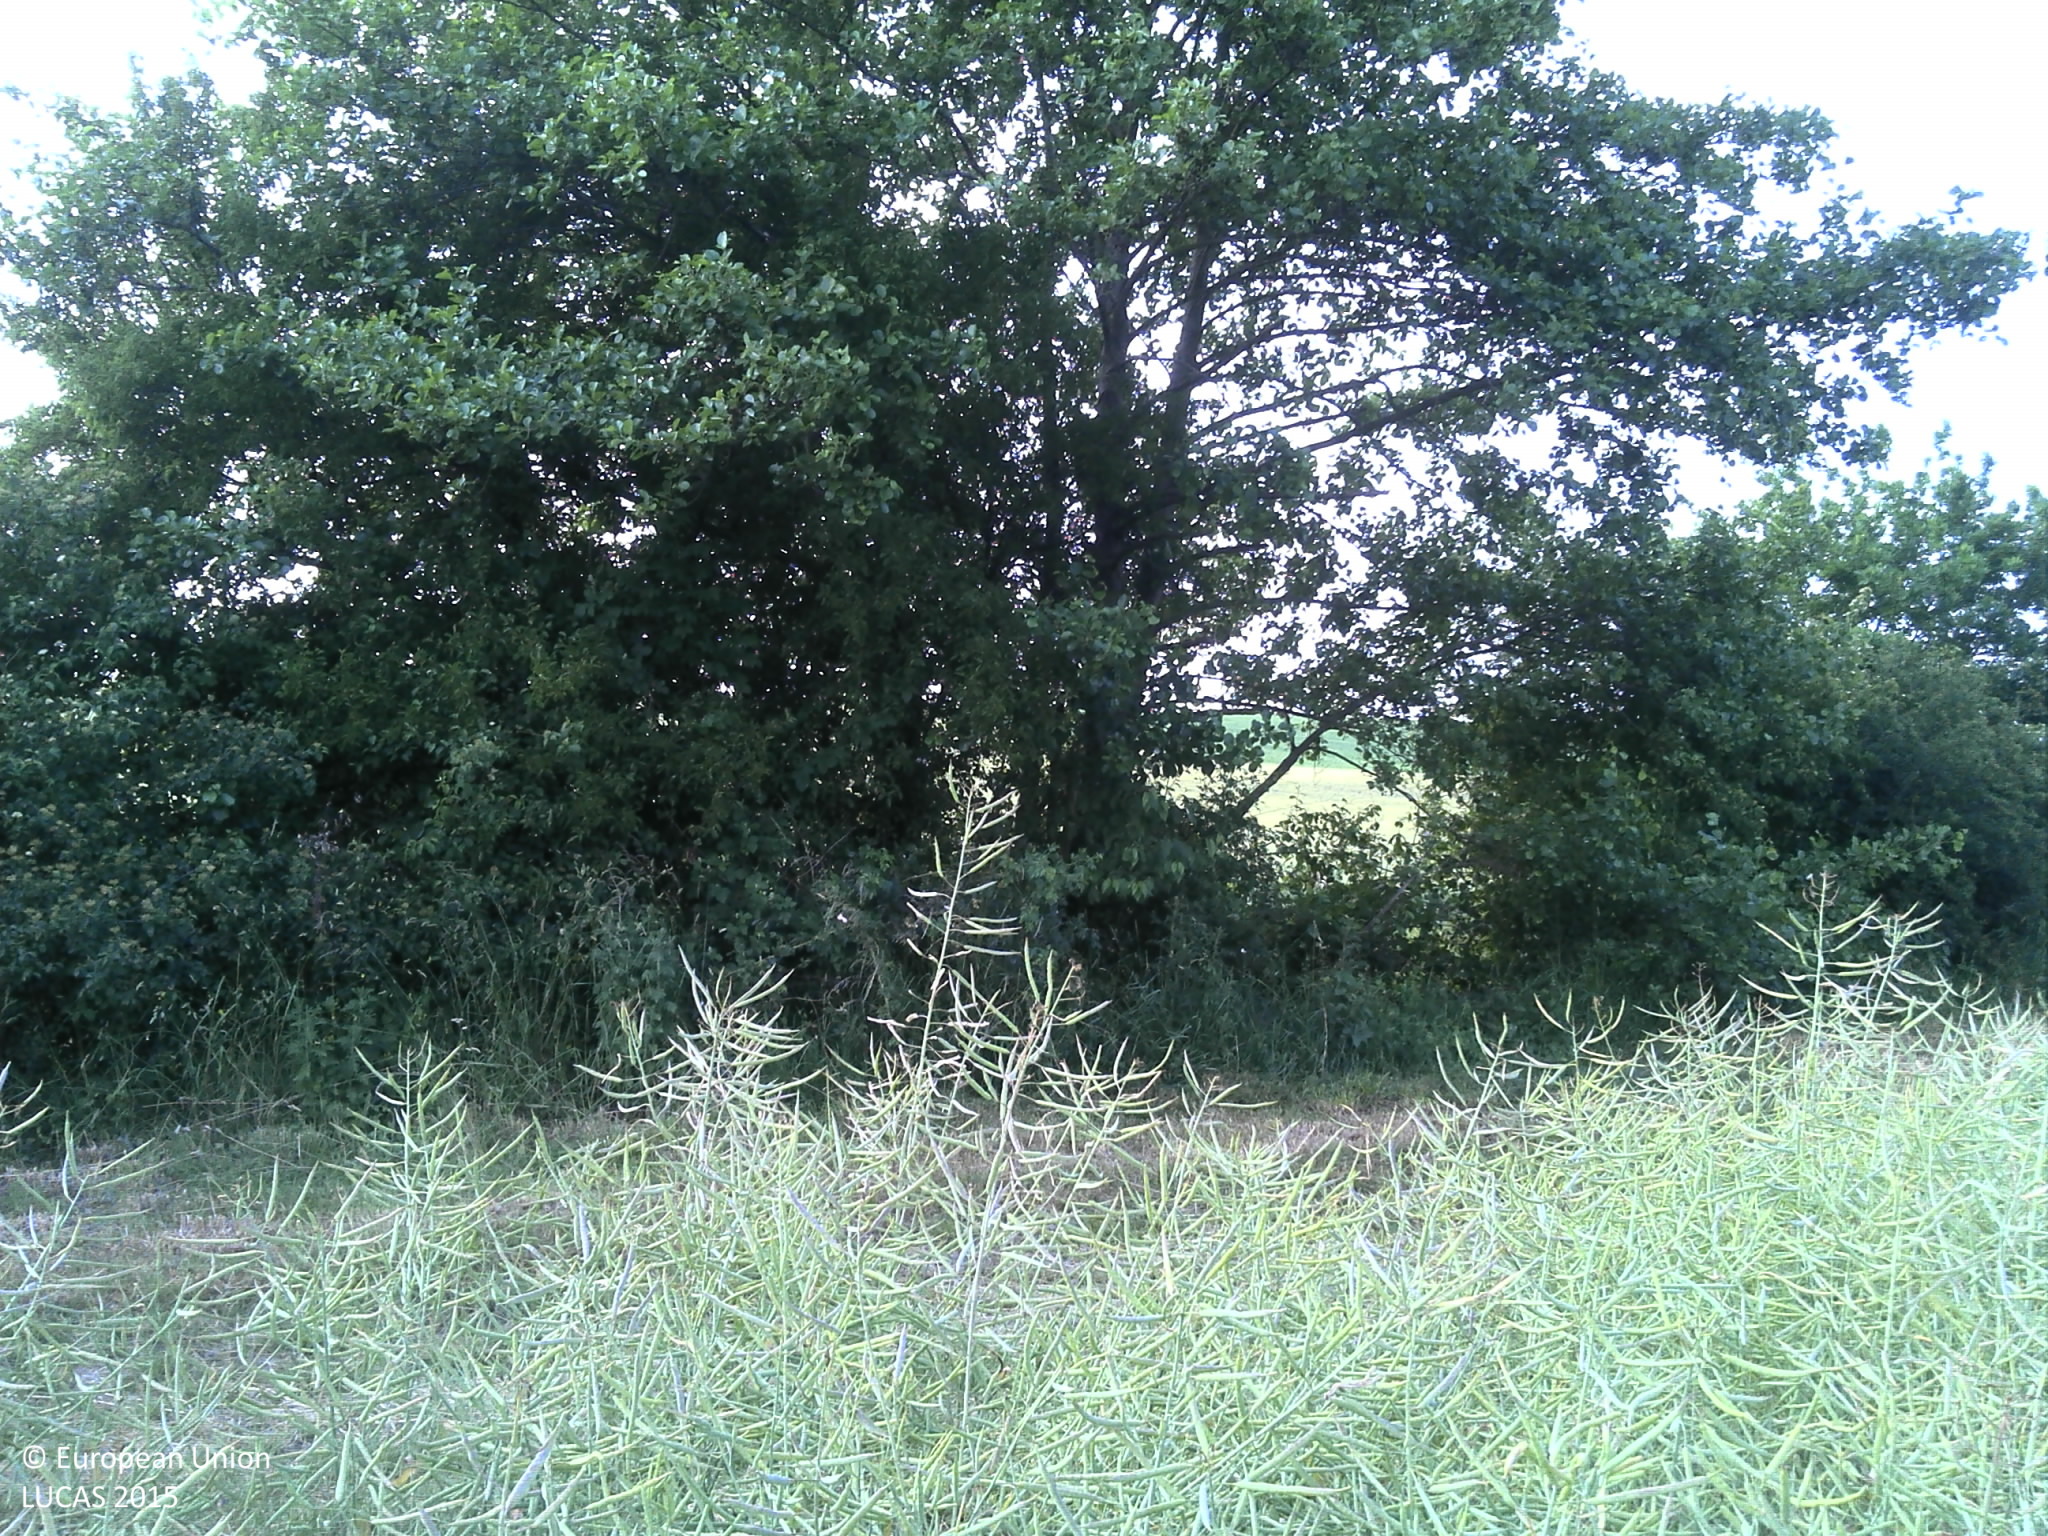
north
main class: Cropland
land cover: Rape and turnip rape
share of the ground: > 75 %
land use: Agriculture (excluding fallow land and kitchen gardens)
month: June
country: FR
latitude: 49.1497
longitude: 6.2295
